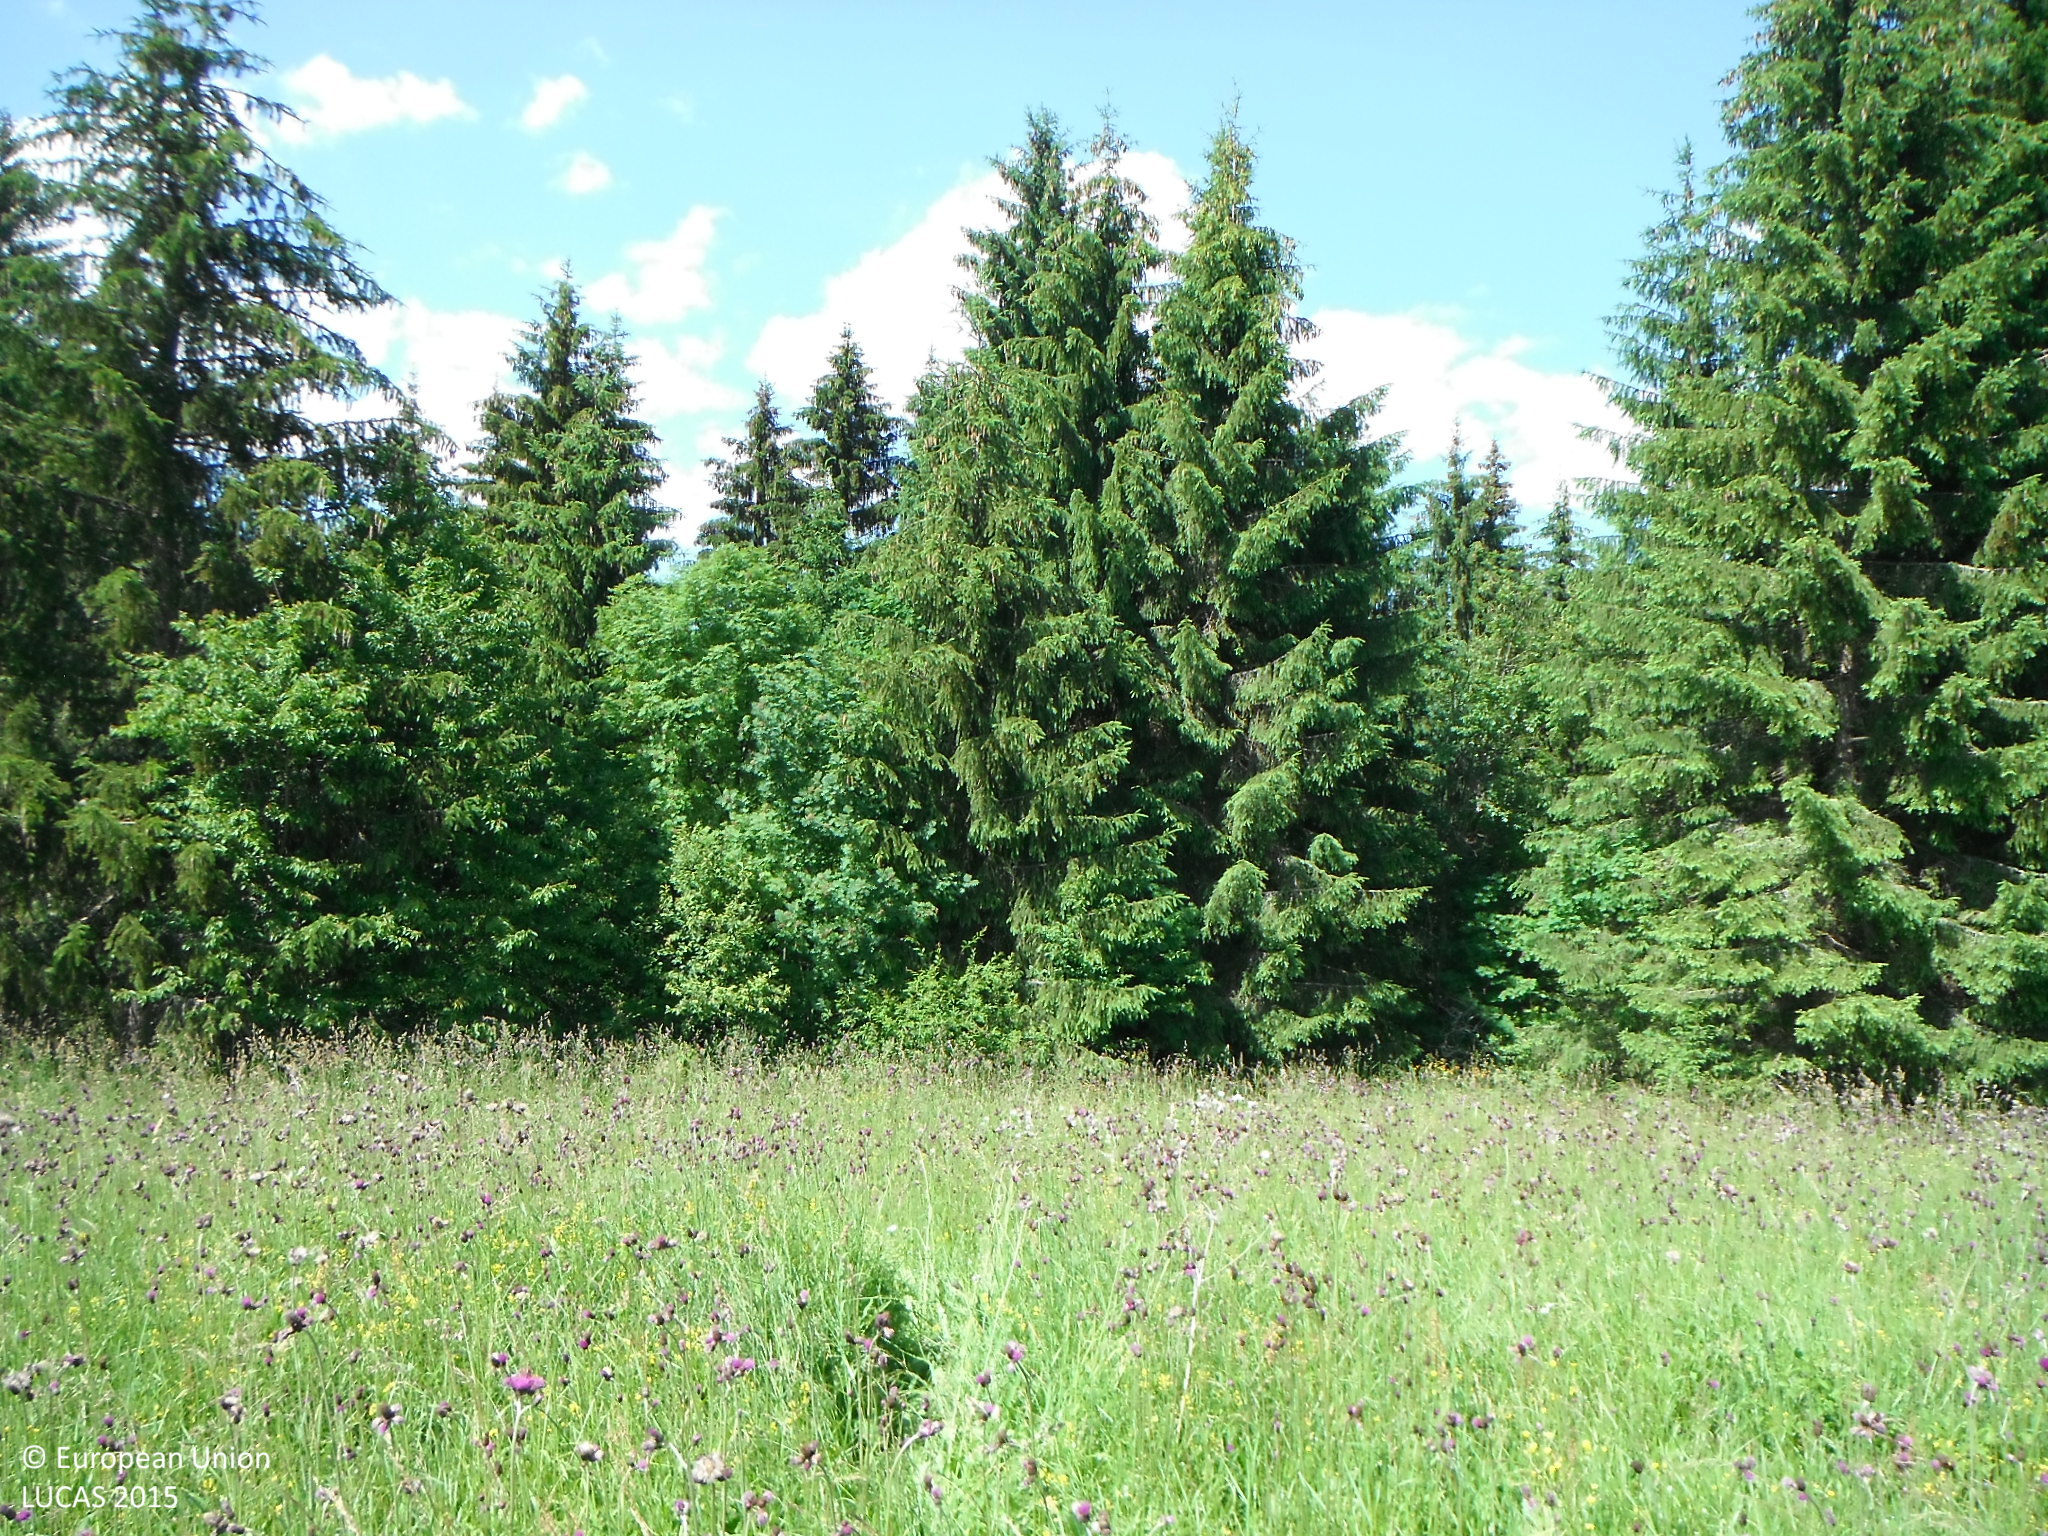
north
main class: Grassland
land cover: Grassland without tree/shrub cover
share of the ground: > 75 %
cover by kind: herbaceous plants 100 %
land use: Agriculture (excluding fallow land and kitchen gardens)
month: July
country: SK
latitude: 49.4696
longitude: 19.3955
